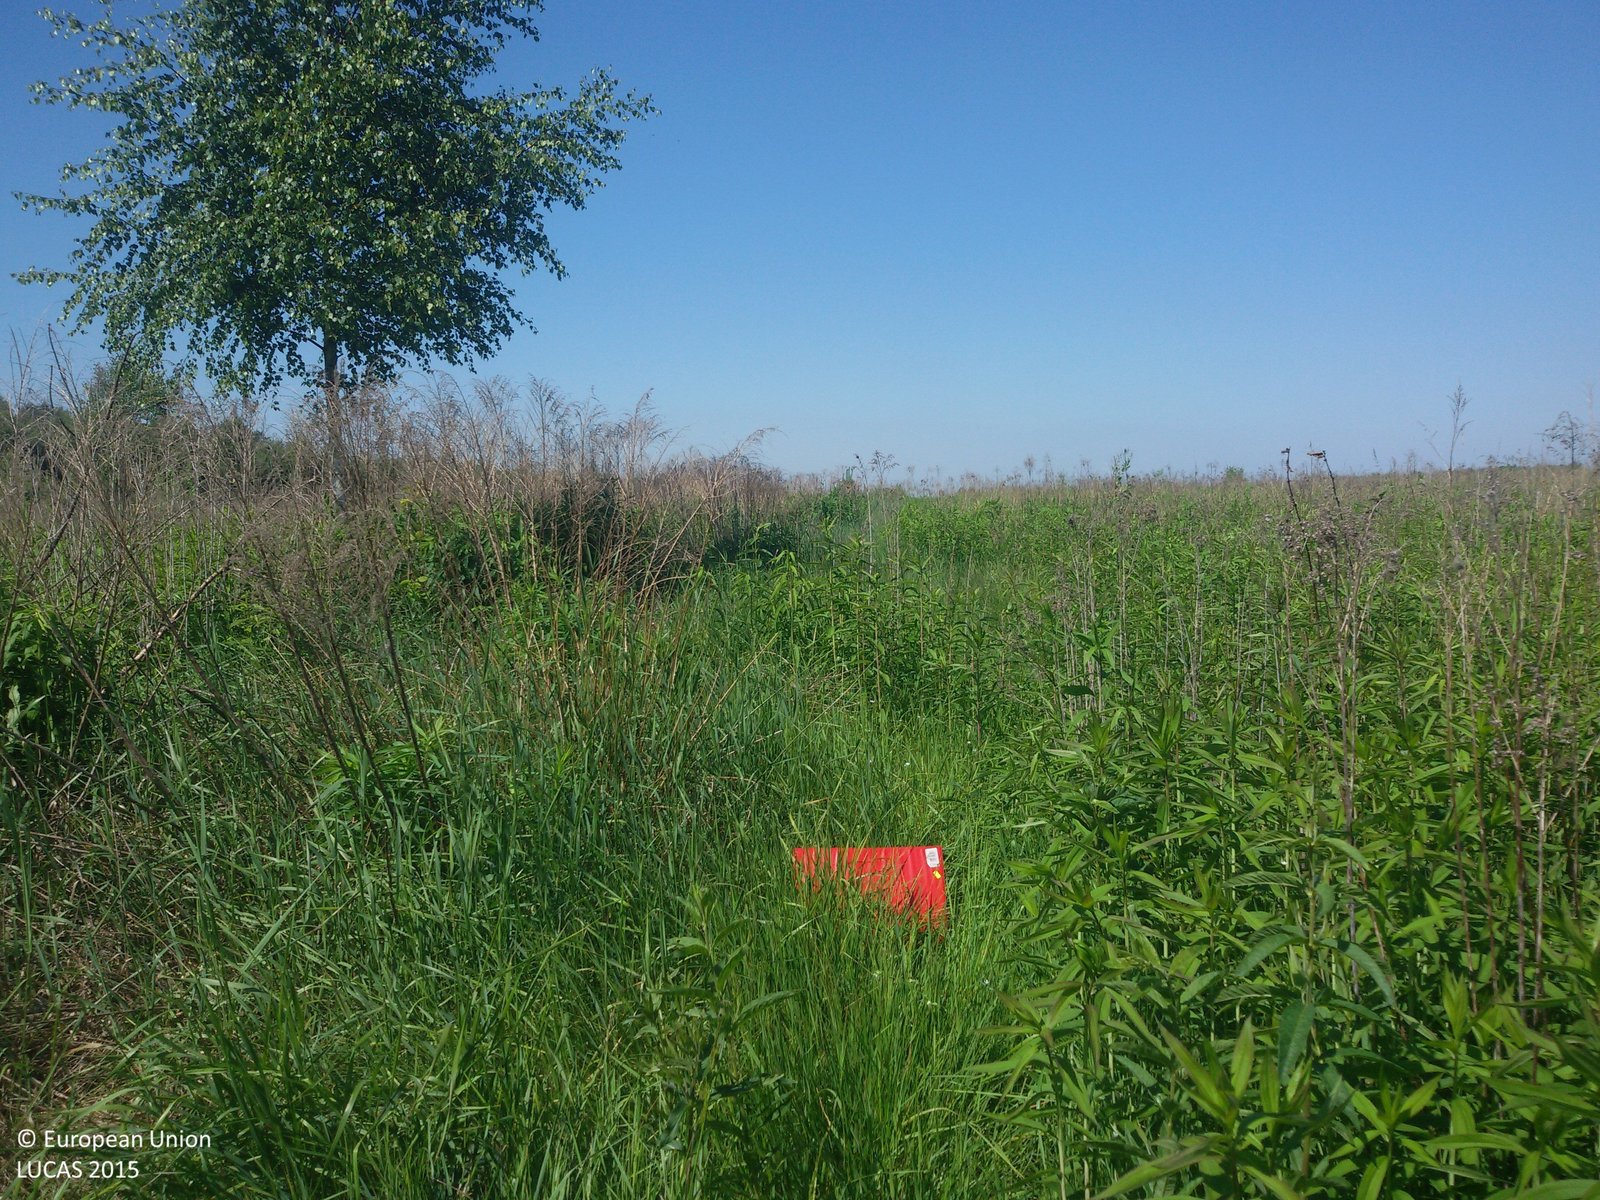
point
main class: Grassland
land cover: Grassland with sparse tree/shrub cover
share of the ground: > 75 %
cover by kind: herbaceous plants 90 %, broadleaved forest trees 5 %, shrubs 5 %
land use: Forestry
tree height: < 5 m
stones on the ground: < 10 %
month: June
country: PL
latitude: 51.4114
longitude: 22.7664
